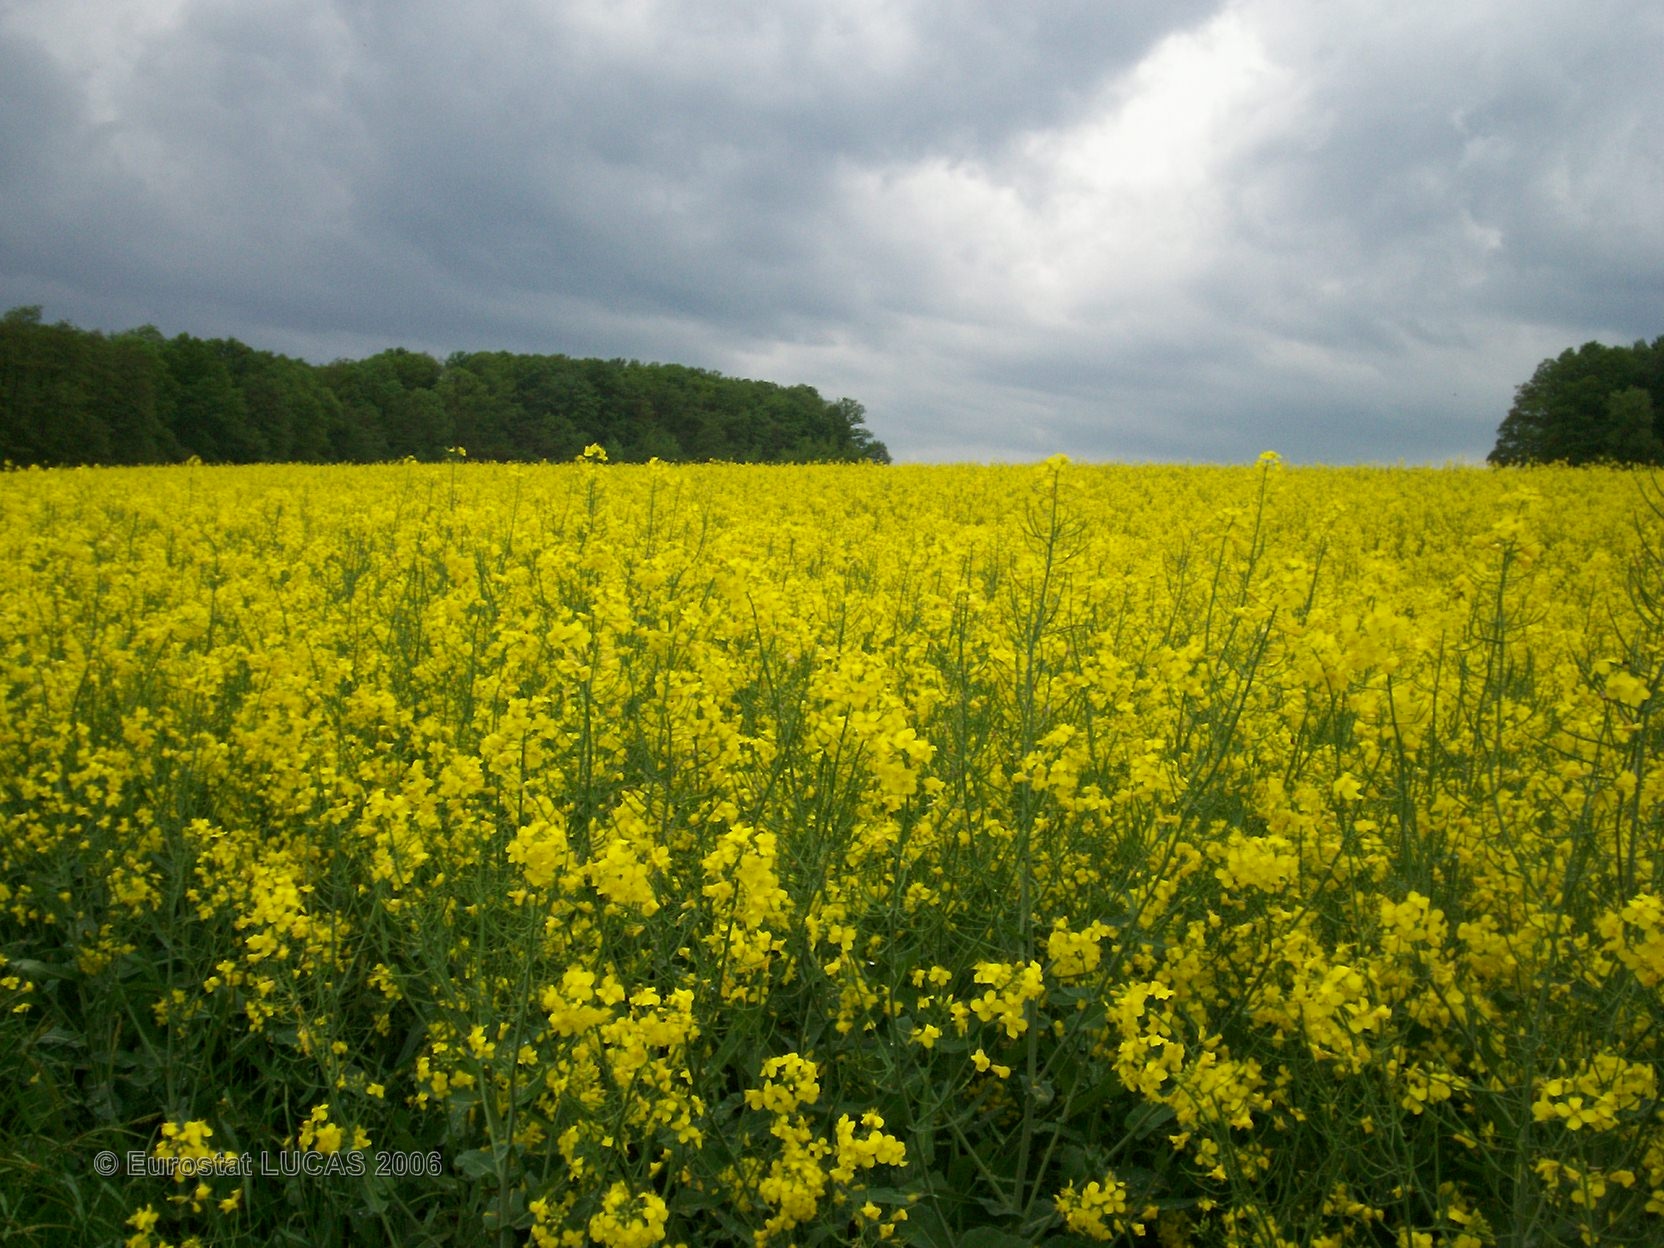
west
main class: Cropland
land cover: Rape and turnip rape
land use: Agriculture (excluding fallow land and kitchen gardens)
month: May
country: FR
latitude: 48.6555
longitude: 6.5387
